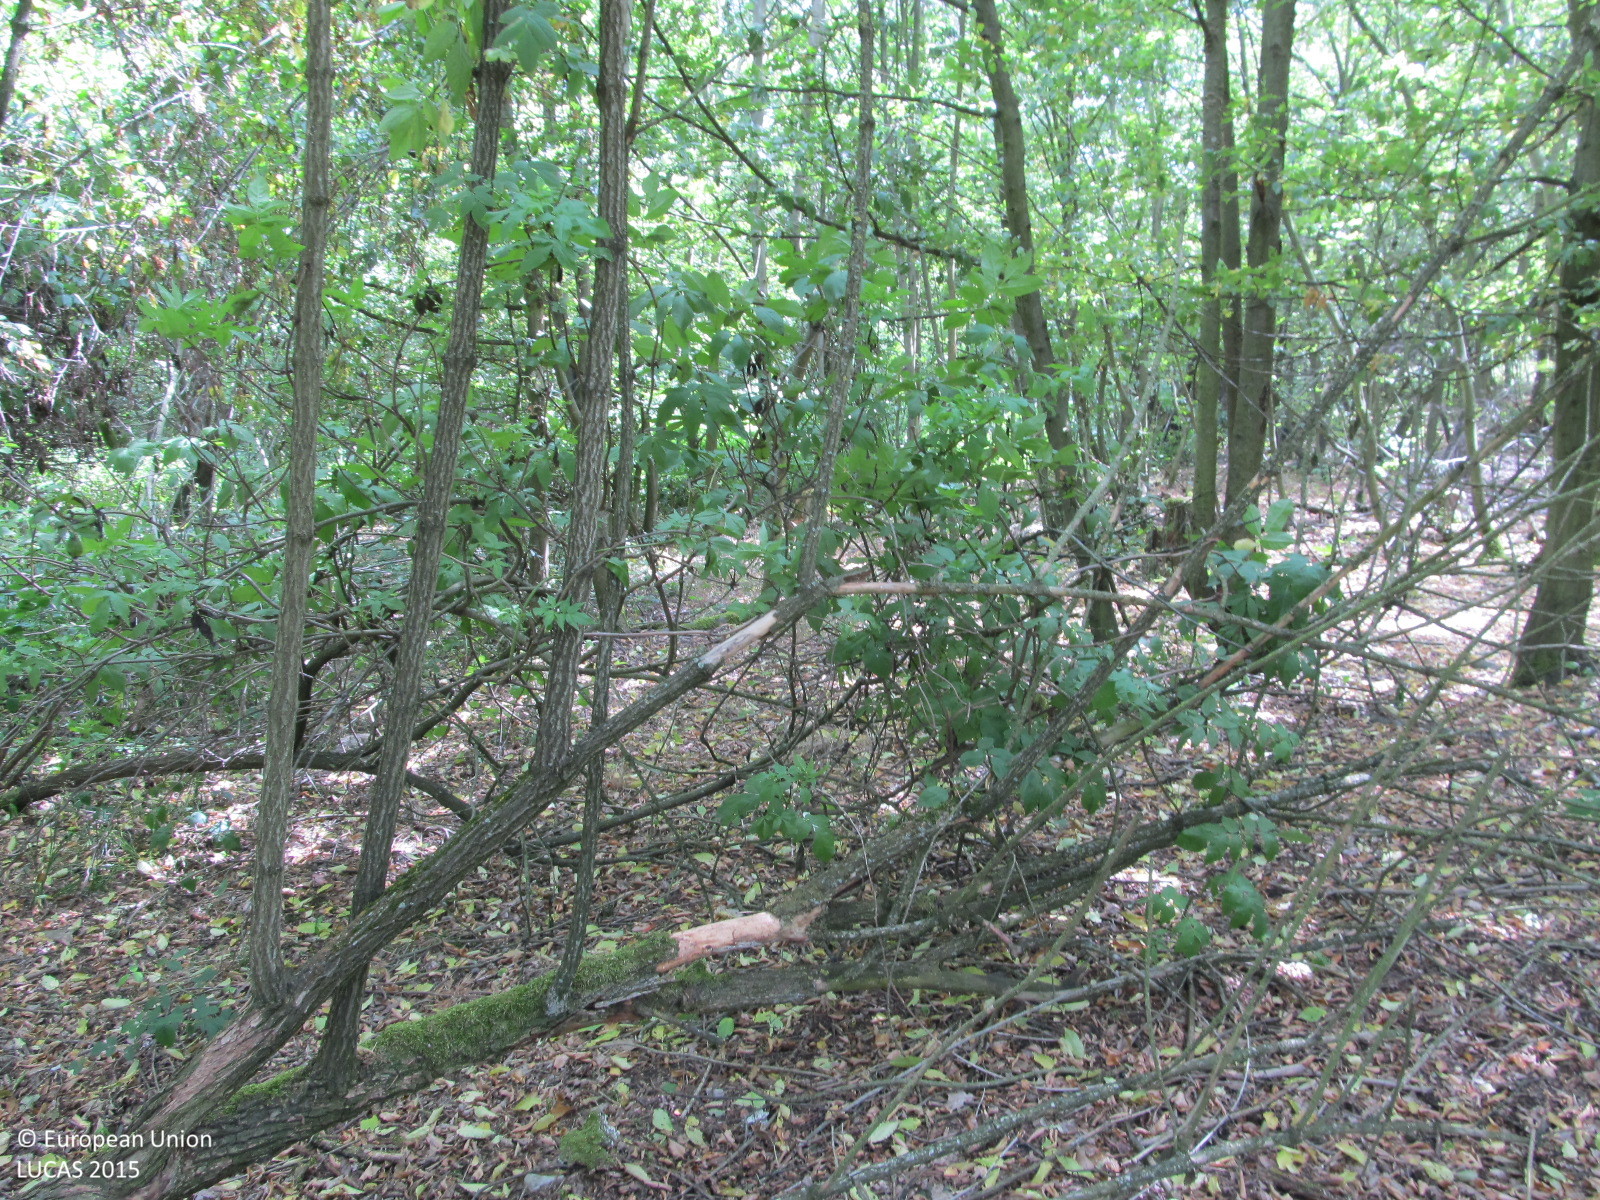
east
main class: Woodland
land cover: Other mixed woodland
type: mountainous beech forest
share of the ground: > 75 %
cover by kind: broadleaved forest trees 60 %, coniferous forest trees 25 %, shrubs 5 %, herbaceous plants 5 %, unconsolidated bare surface 5 %
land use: Forestry
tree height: > 5 m
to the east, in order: Other mixed woodland; Fences; Other mixed woodland
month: July
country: AT
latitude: 48.8037
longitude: 15.9271
